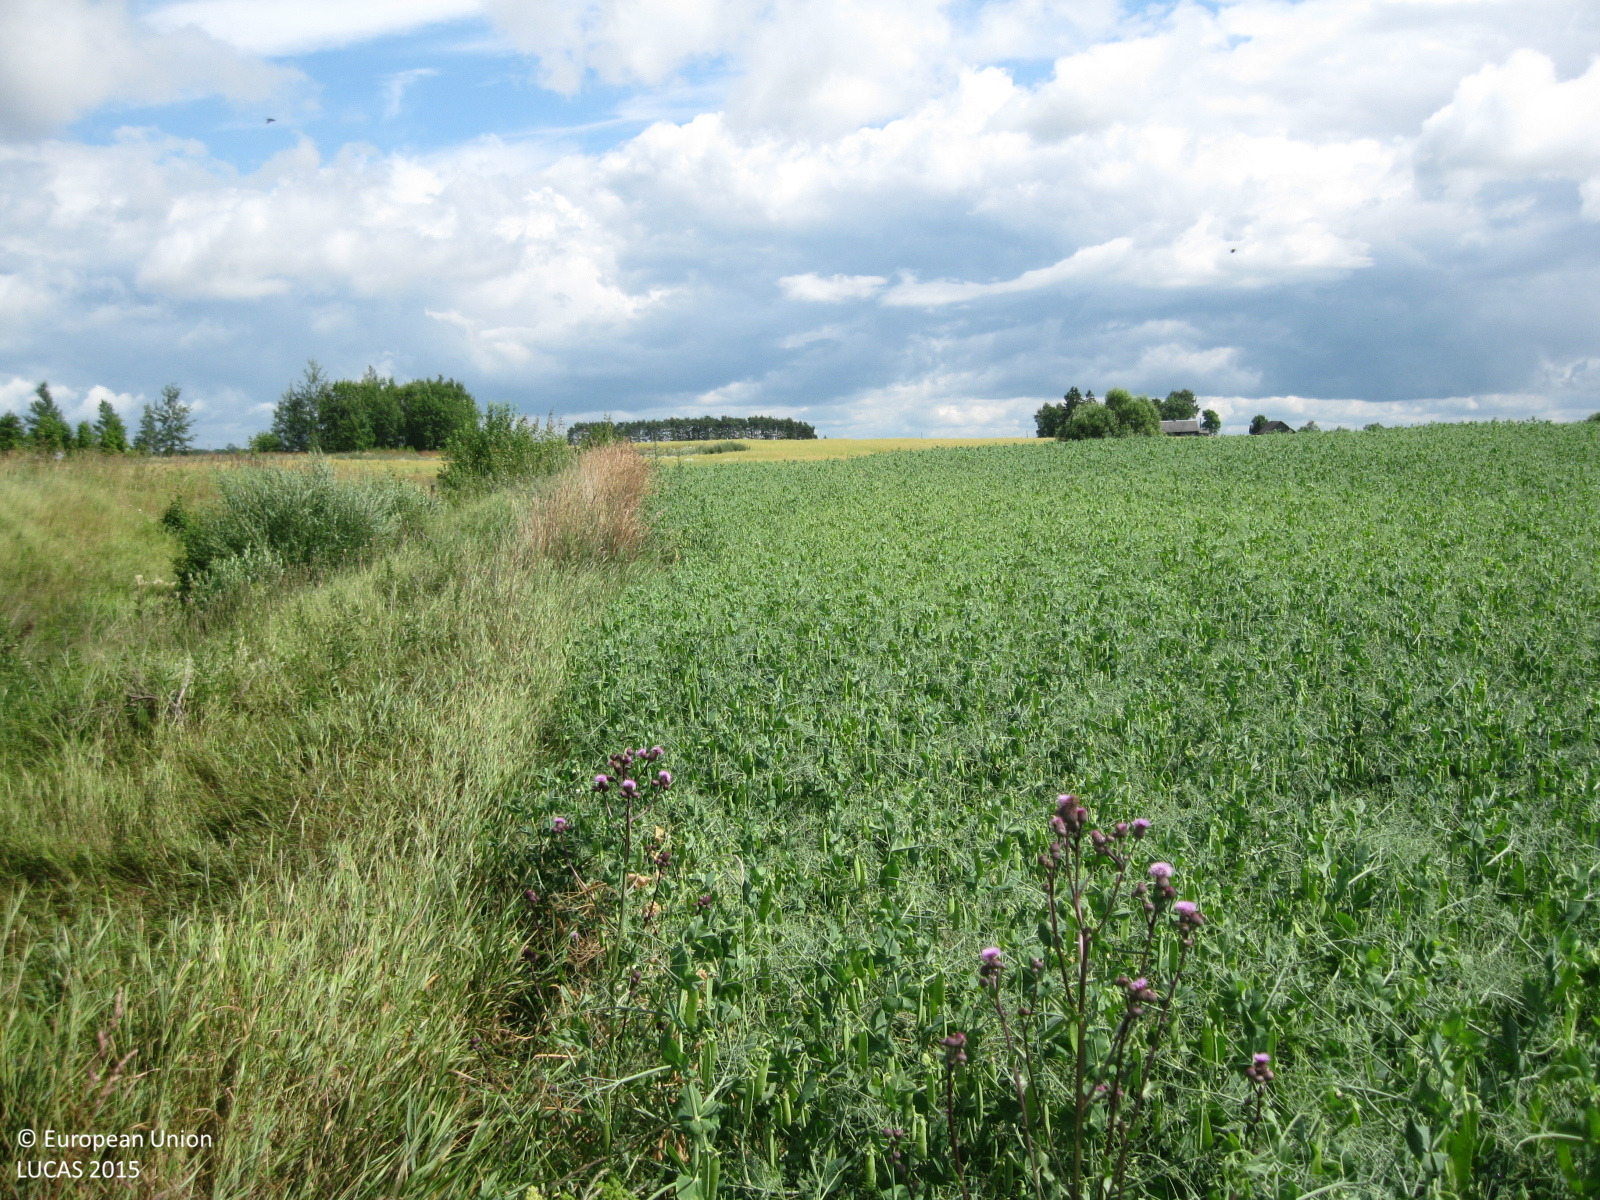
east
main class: Cropland
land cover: Dry pulses
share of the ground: > 75 %
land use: Agriculture (excluding fallow land and kitchen gardens)
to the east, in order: Dry pulses; Grass margins; Tracks; Grassland with sparse tree/shrub cover; Inland fresh running water; Grassland with sparse tree/shrub cover; Rape and turnip rape
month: July
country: LT
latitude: 55.6919
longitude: 24.3010
